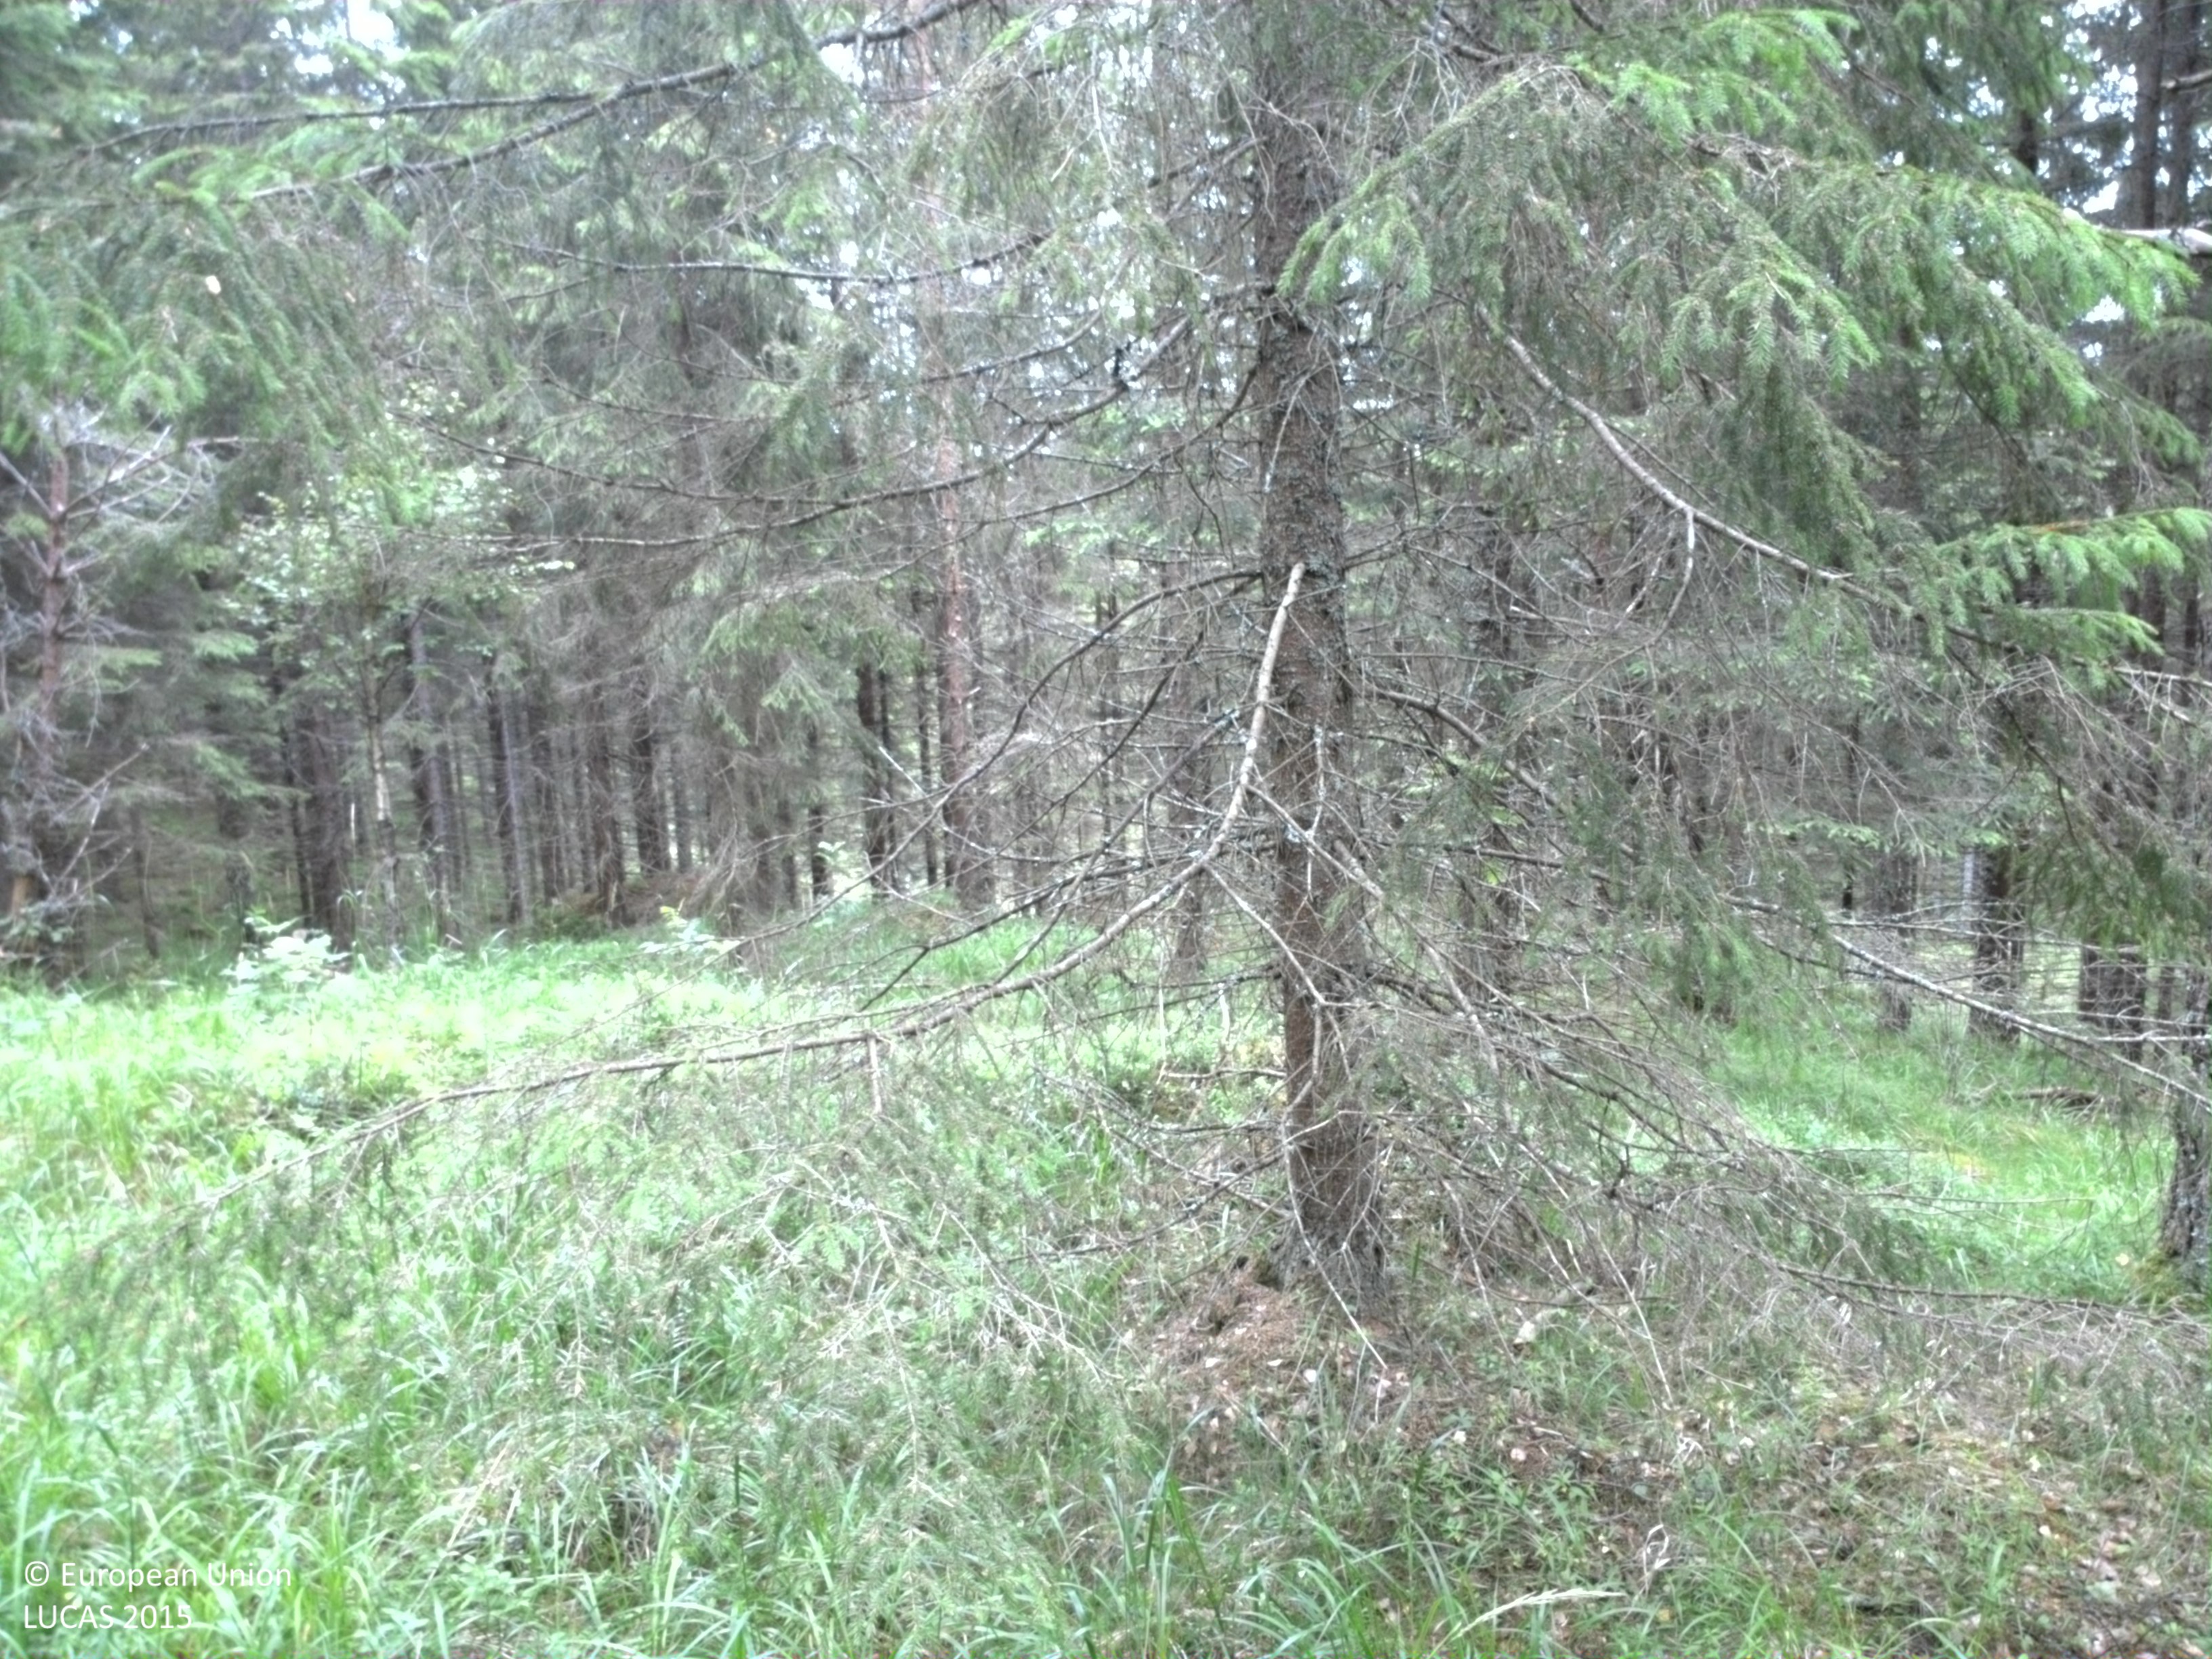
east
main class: Woodland
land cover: Spruce dominated mixed woodland
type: boreal forest
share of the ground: 25 - 50 %
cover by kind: coniferous forest trees 35 %, herbaceous plants 25 %, broadleaved forest trees 15 %, shrubs 15 %, lichens and mosses 10 %
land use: Forestry
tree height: > 5 m
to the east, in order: Spruce dominated mixed woodland; Spruce dominated coniferous woodland; Tracks; Spruce dominated mixed woodland; Spruce dominated coniferous woodland; Tracks; Spruce dominated coniferous woodland
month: July
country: SE
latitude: 59.6093
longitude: 11.9264
